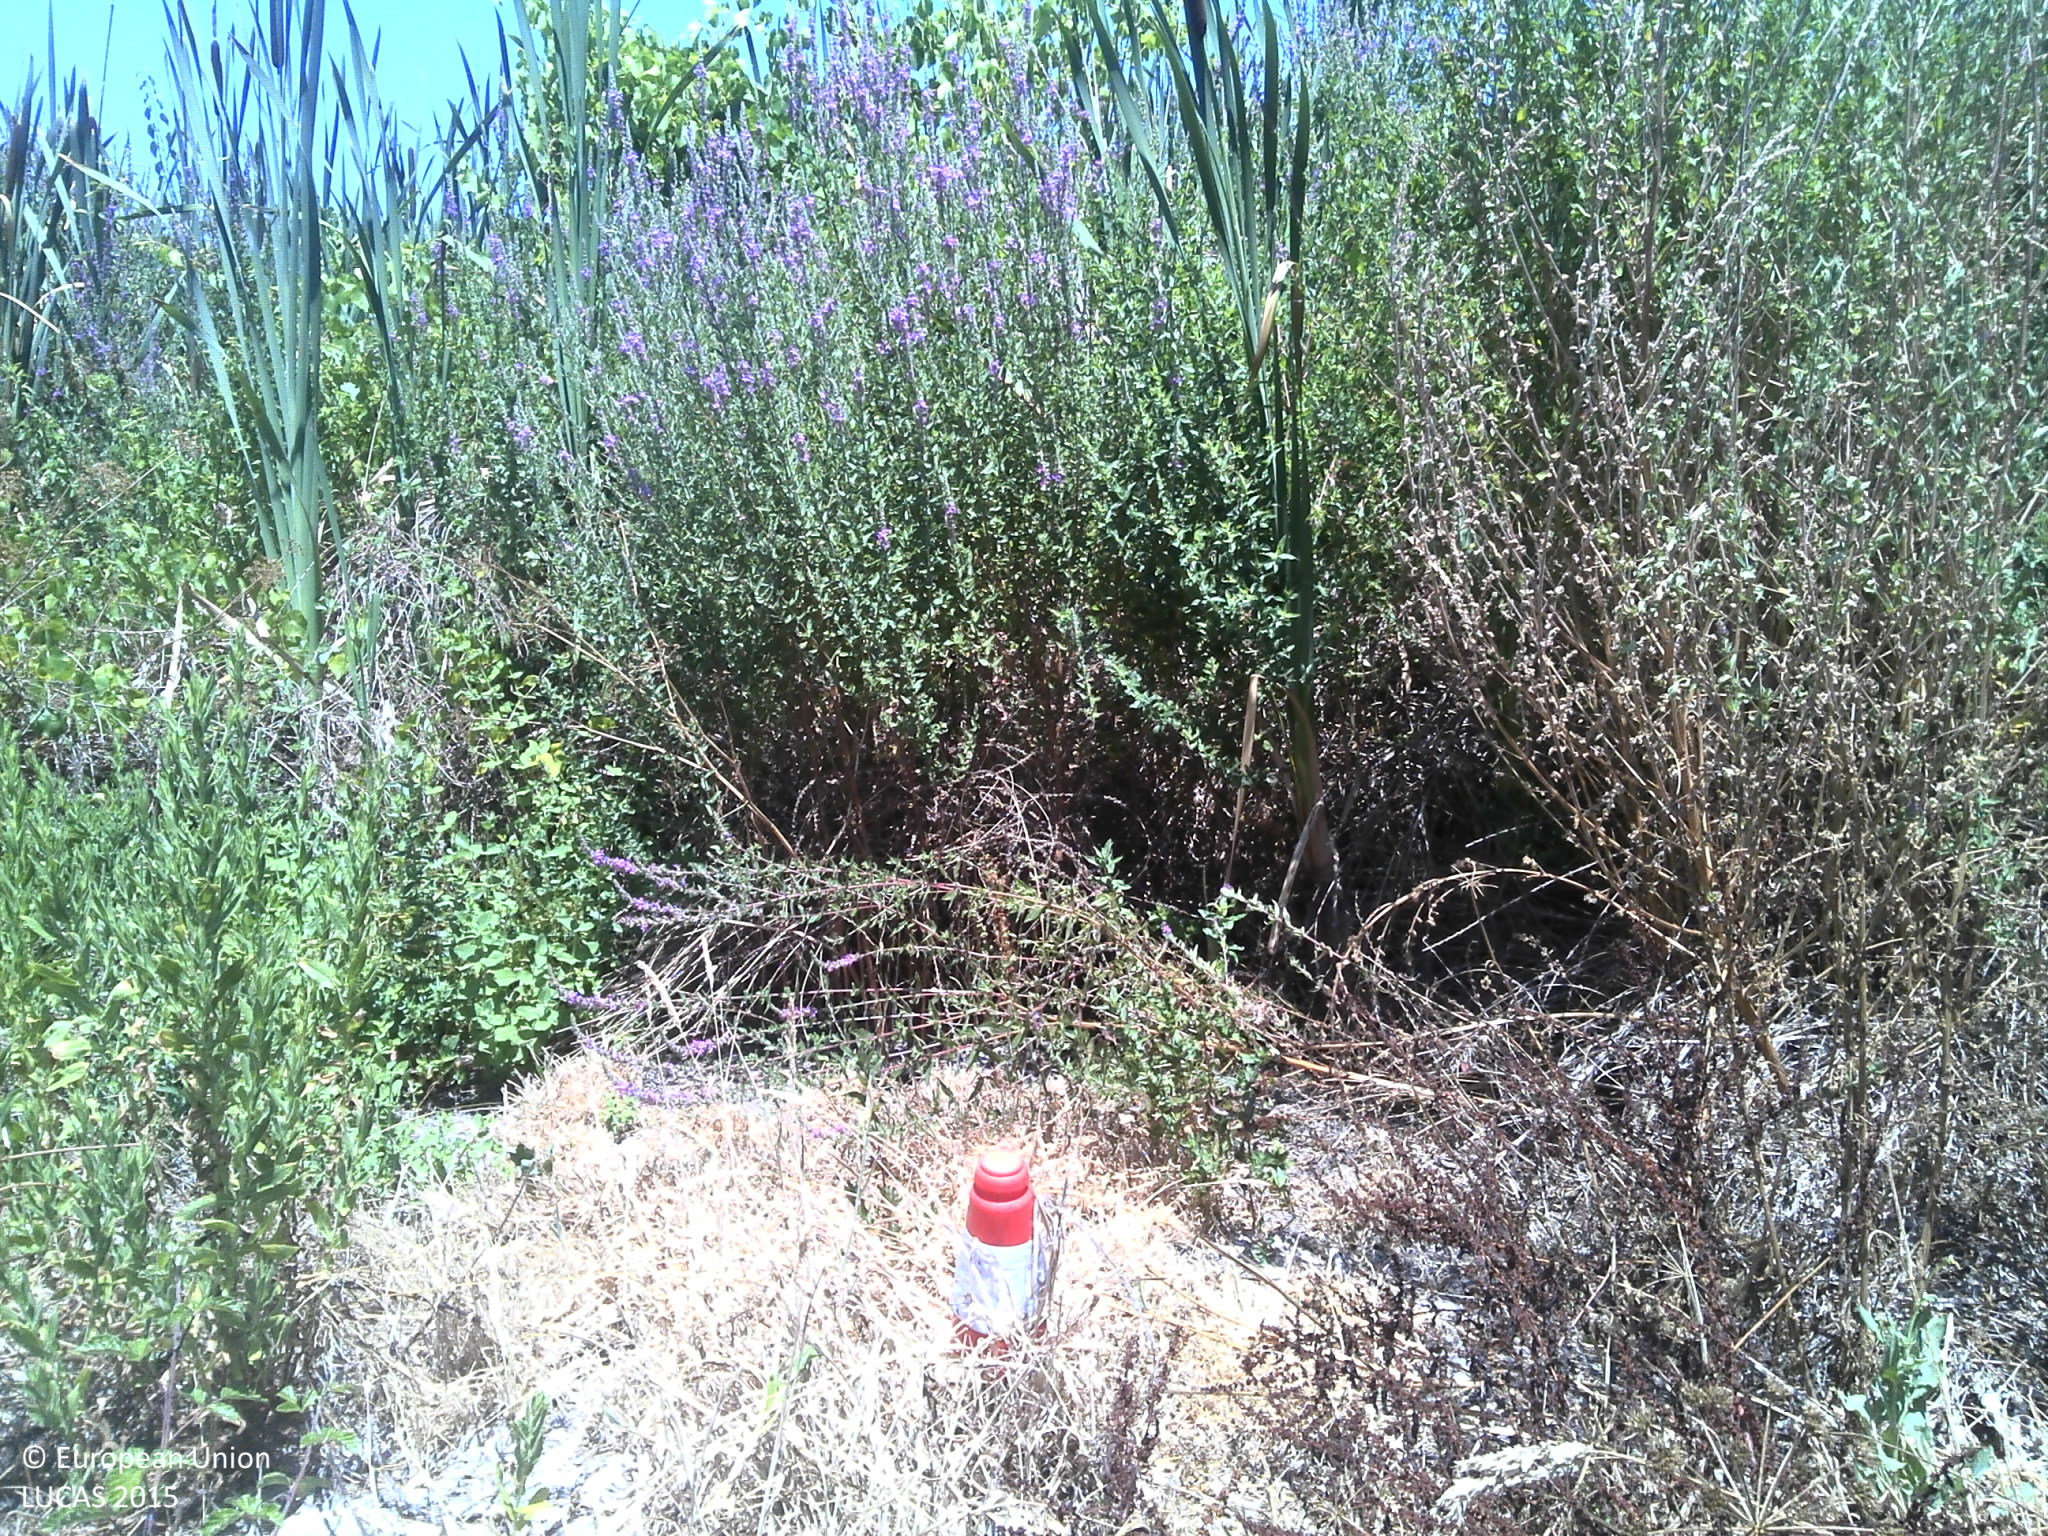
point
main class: Shrubland
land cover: Shrubland without tree cover
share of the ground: > 75 %
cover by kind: shrubs 80 %, herbaceous plants 10 %, unconsolidated bare surface 5 %
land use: Abandoned areas
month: July
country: PT
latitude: 40.4066
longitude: -7.3447
